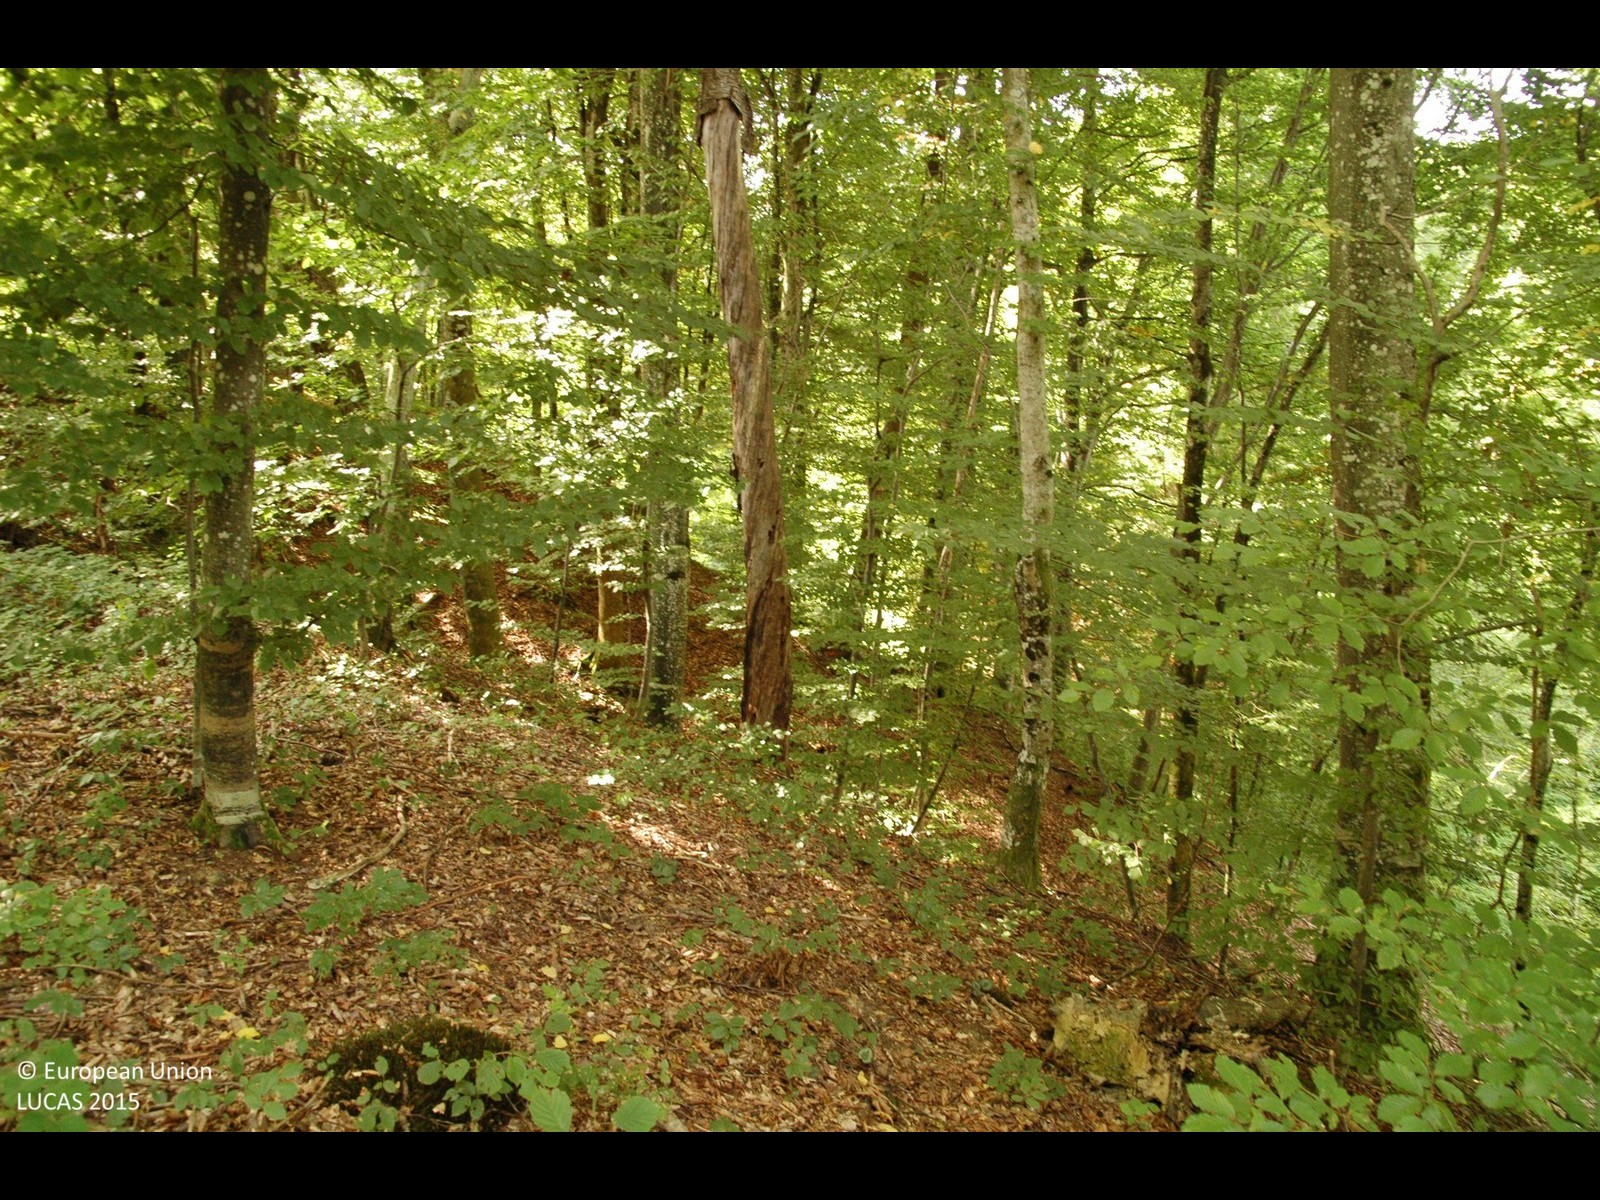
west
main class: Woodland
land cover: Broadleaved woodland
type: mesophytic deciduous forest
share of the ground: > 75 %
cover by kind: broadleaved forest trees 100 %
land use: Forestry
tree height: > 5 m
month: September
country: HR
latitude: 45.5740
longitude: 15.9045
